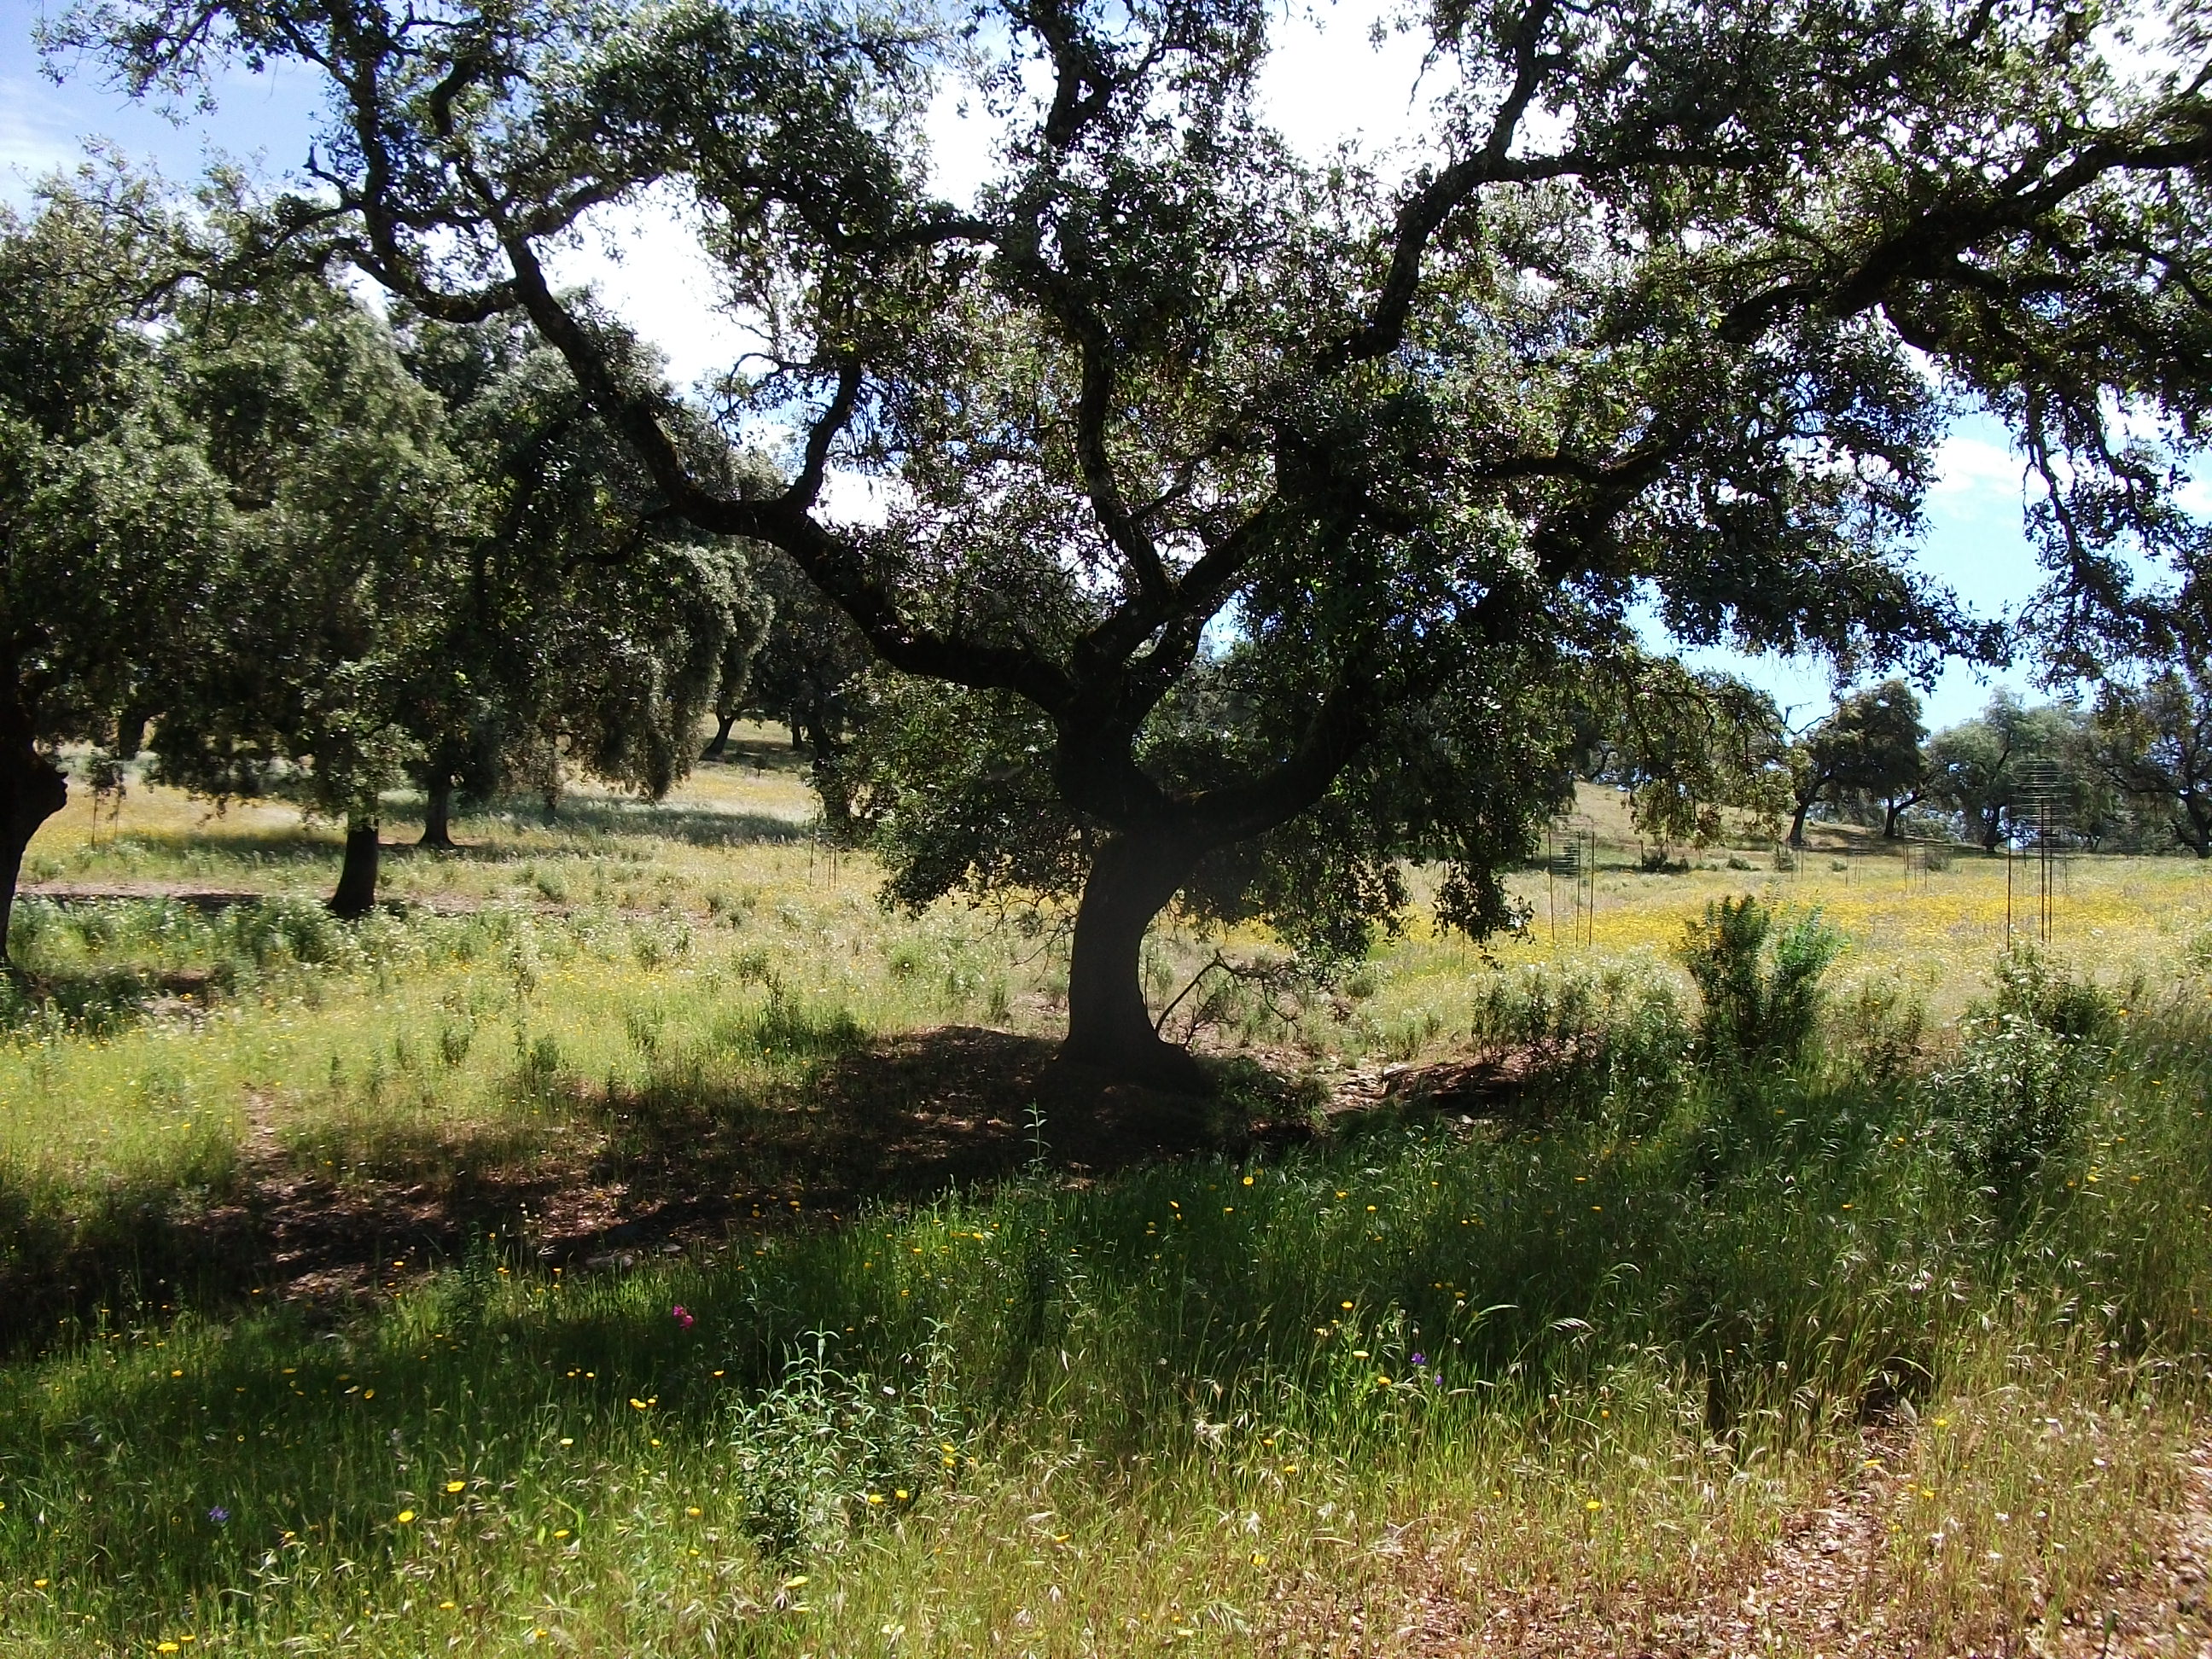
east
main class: Woodland
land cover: Broadleaved woodland
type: broadleaved evergreen forest
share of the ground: 25 - 50 %
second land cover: Grassland without tree/shrub cover
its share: > 75 %
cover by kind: broadleaved forest trees 50 %, herbaceous plants 50 %
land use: Forestry
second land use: Agriculture (excluding fallow land and kitchen gardens)
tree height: > 5 m
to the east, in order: Broadleaved woodland; Grassland without tree/shrub cover; Tracks; Broadleaved woodland; Fences; Grassland without tree/shrub cover; Tracks; Broadleaved woodland; Electric lines; Broadleaved woodland; Electric lines; Grassland with sparse tree/shrub cover
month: May
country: ES
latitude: 37.9297
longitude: -7.0627
